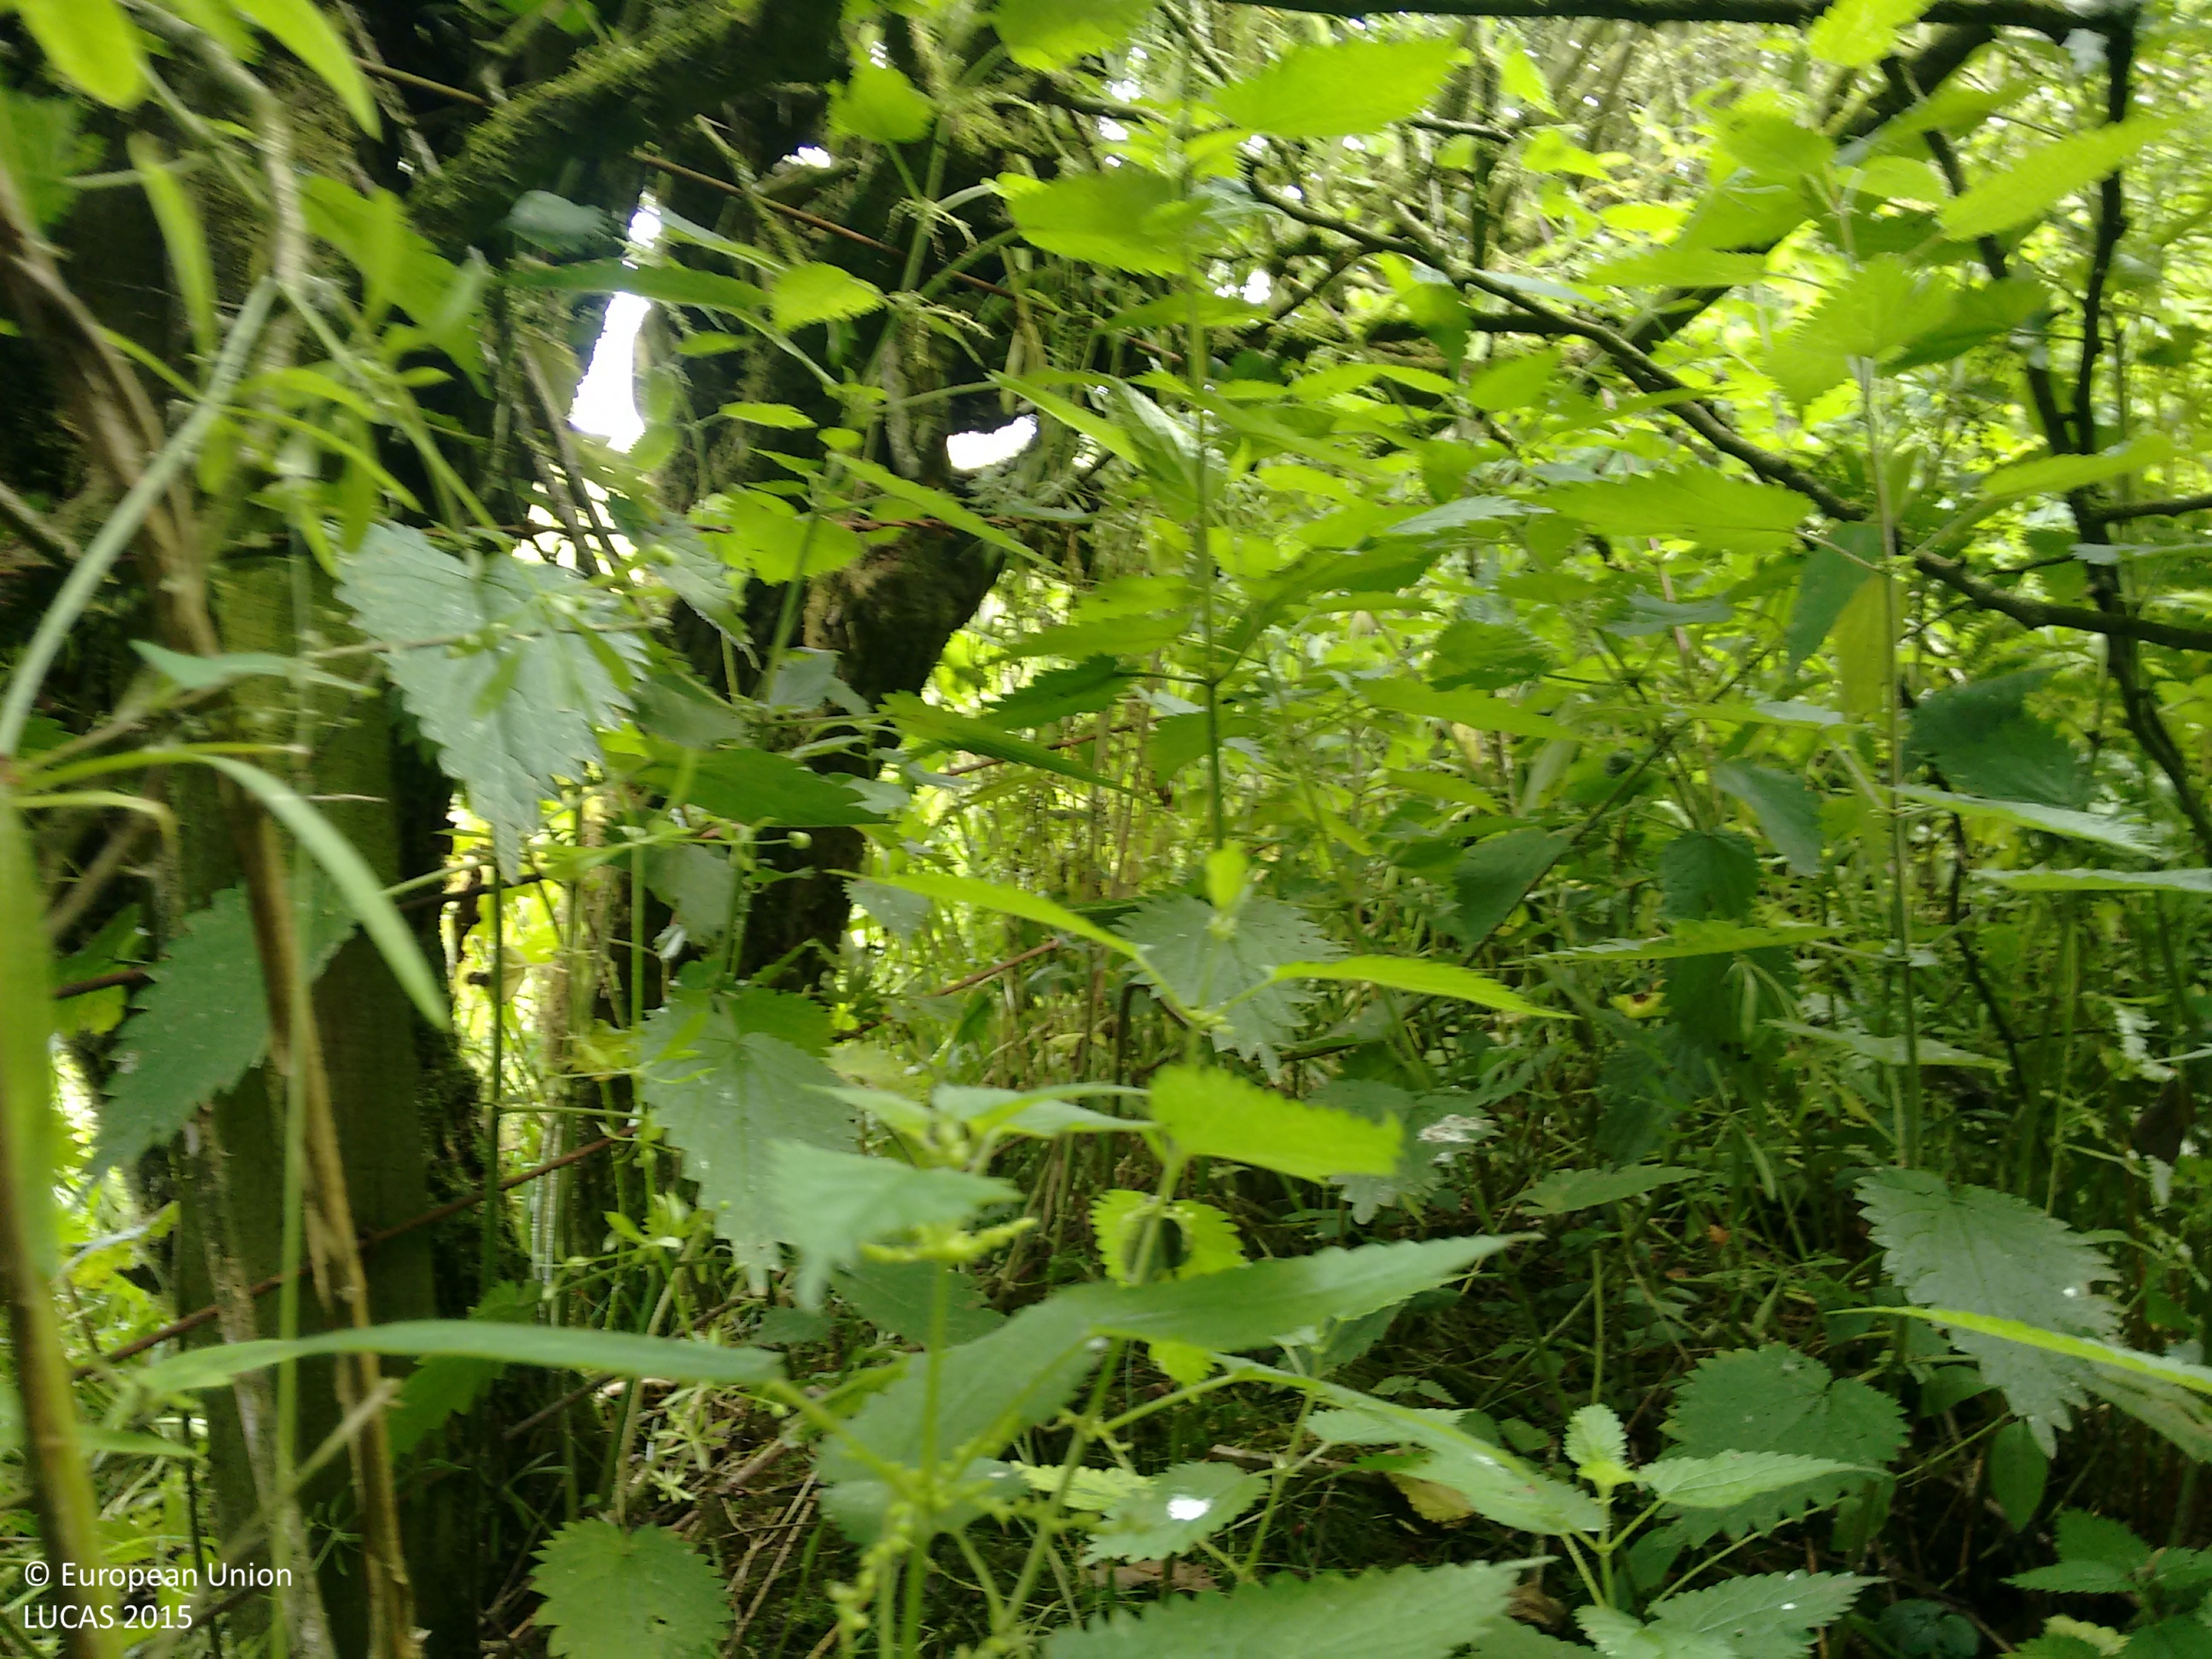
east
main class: Grassland
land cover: Grassland without tree/shrub cover
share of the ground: < 10 %
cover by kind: herbaceous plants 100 %
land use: Agriculture (excluding fallow land and kitchen gardens)
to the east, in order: Grassland without tree/shrub cover; Conifer hedges; Grassland without tree/shrub cover
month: July
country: GB
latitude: 55.5372
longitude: -4.3740
